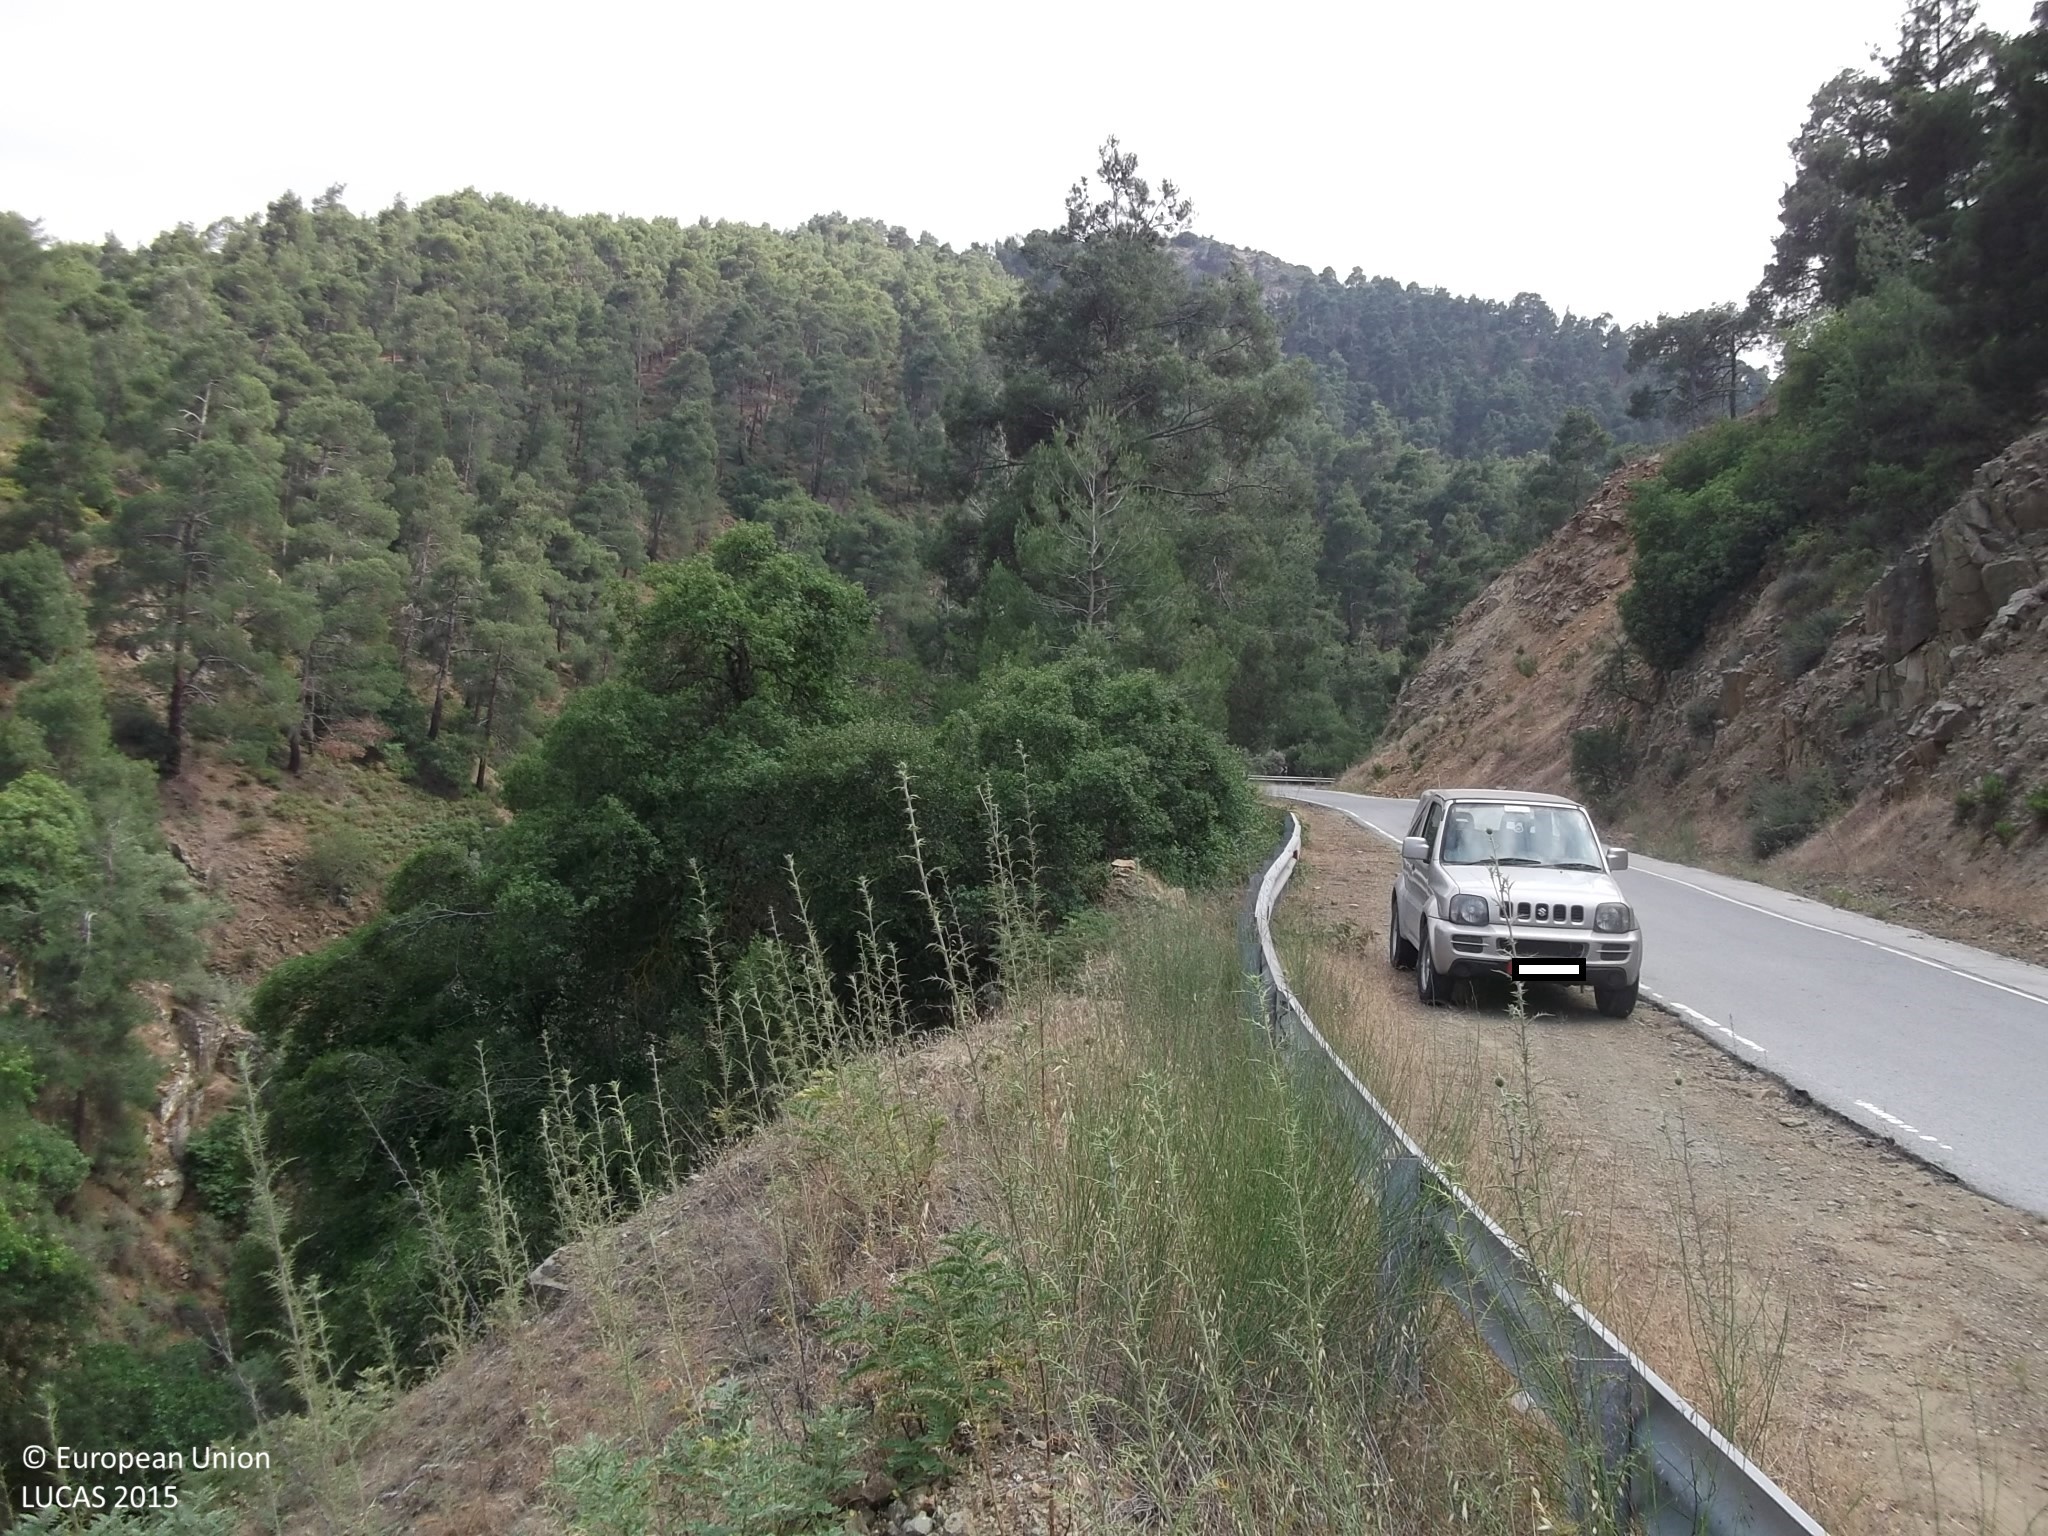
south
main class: Woodland
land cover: Pine dominated coniferous woodland
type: coniferous forest of the mediterranean region
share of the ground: 50 - 75 %
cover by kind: coniferous forest trees 60 %, shrubs 20 %, consolidated bare surface 10 %, unconsolidated bare surface 10 %
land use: Forestry
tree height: > 5 m
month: June
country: CY
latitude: 35.0010
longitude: 32.9970
